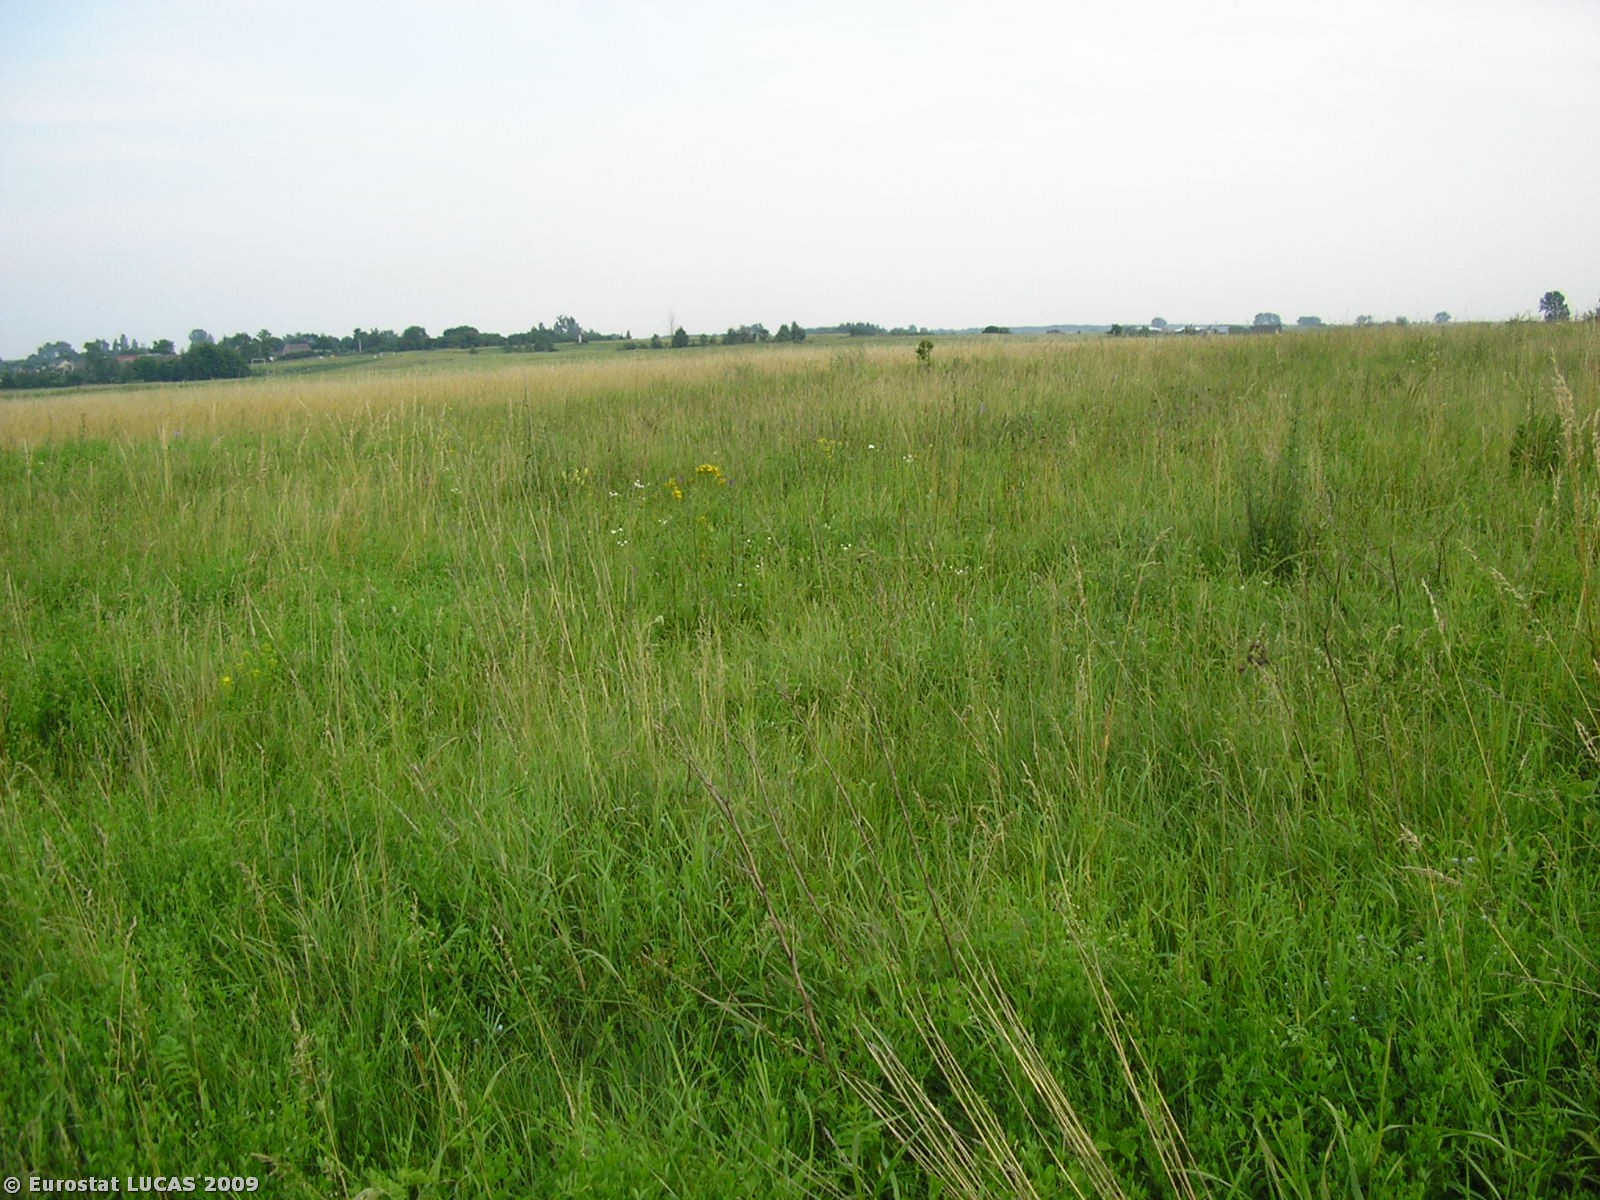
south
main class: Grassland
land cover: Grassland without tree/shrub cover
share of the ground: > 75 %
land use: Agriculture (excluding fallow land and kitchen gardens)
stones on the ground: < 10 %
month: June
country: PL
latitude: 50.4234
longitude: 20.6954
